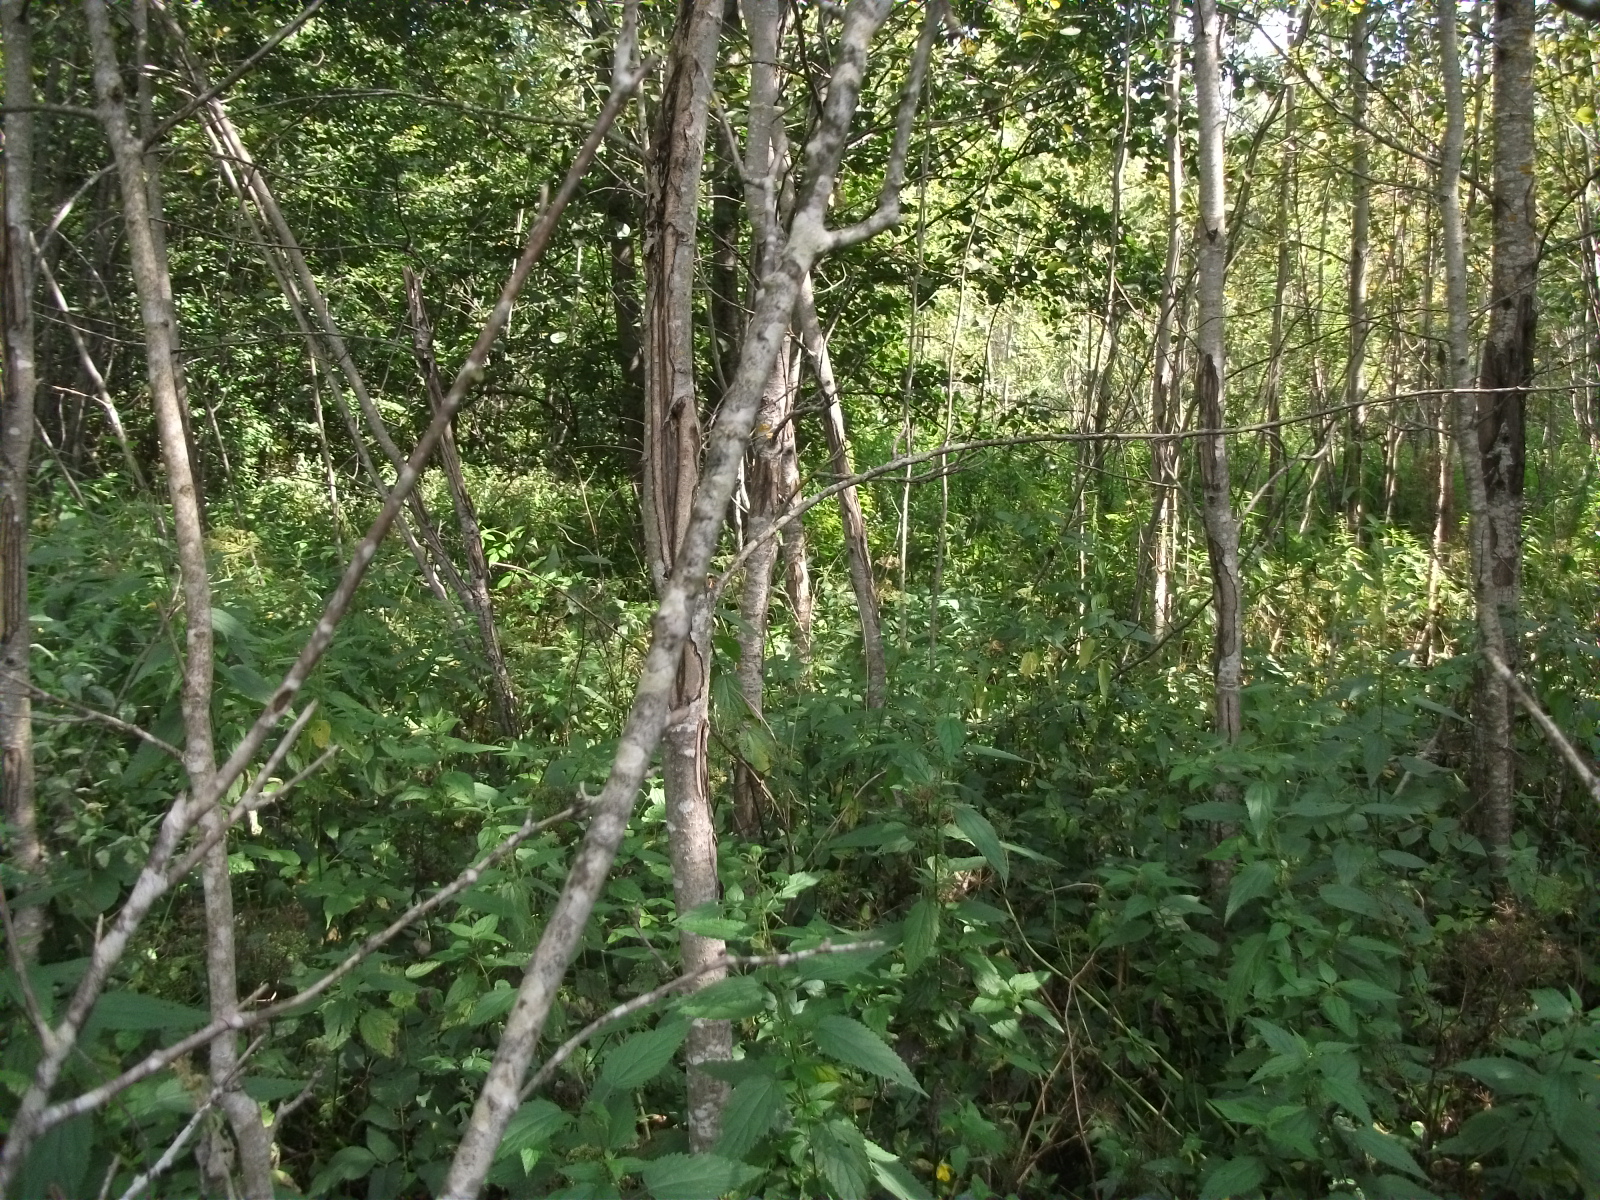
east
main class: Woodland
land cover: Broadleaved woodland
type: non-riverine alder, birch or aspen forest
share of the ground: 50 - 75 %
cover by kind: broadleaved forest trees 70 %, herbaceous plants 20 %, shrubs 10 %
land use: Forestry
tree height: > 5 m
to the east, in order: Broadleaved woodland; Spontaneously vegetated surfaces; Ditches and canals; Spontaneously vegetated surfaces; Tracks; Shruby margins; Ditches and canals; Spontaneously vegetated surfaces; Electric lines; Spontaneously vegetated surfaces; Broadleaved woodland; Spruce dominated mixed woodland
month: August
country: LV
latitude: 56.8697
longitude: 26.4008
